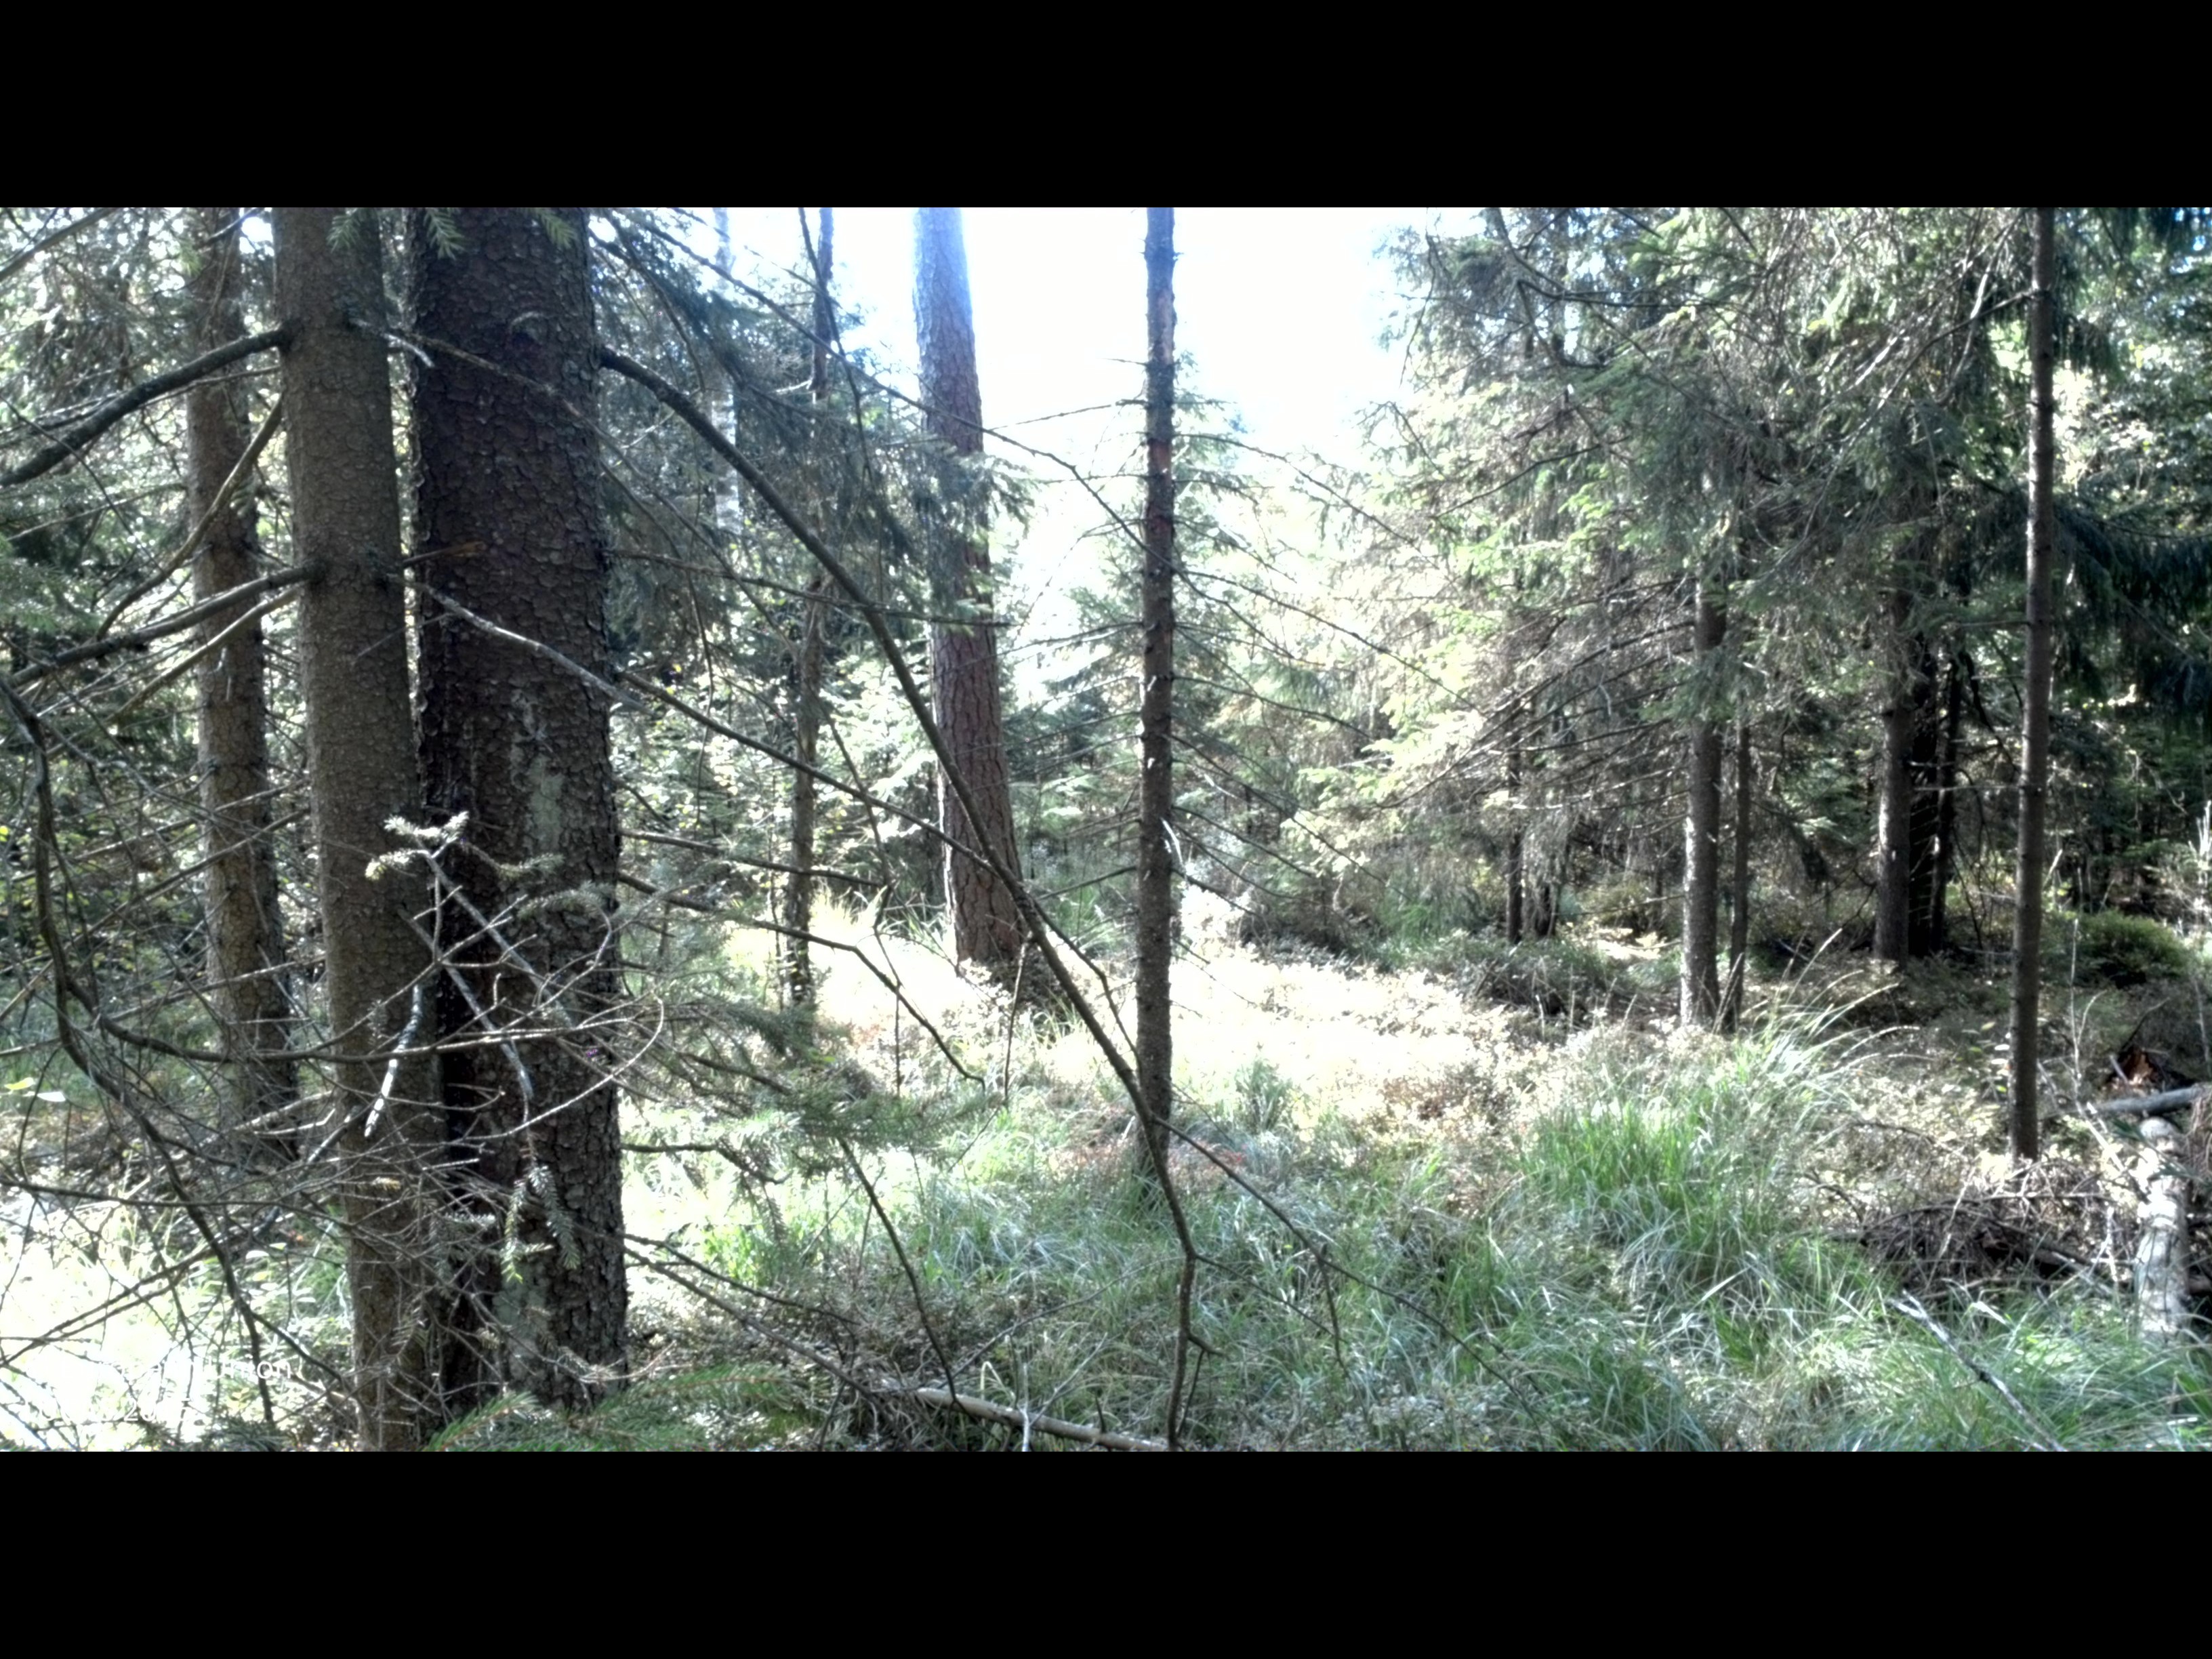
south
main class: Woodland
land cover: Spruce dominated coniferous woodland
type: boreal forest
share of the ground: 50 - 75 %
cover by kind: coniferous forest trees 65 %, shrubs 25 %, broadleaved forest trees 5 %, herbaceous plants 5 %
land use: Forestry
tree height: > 5 m
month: September
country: SE
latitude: 56.8147
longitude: 13.1582
